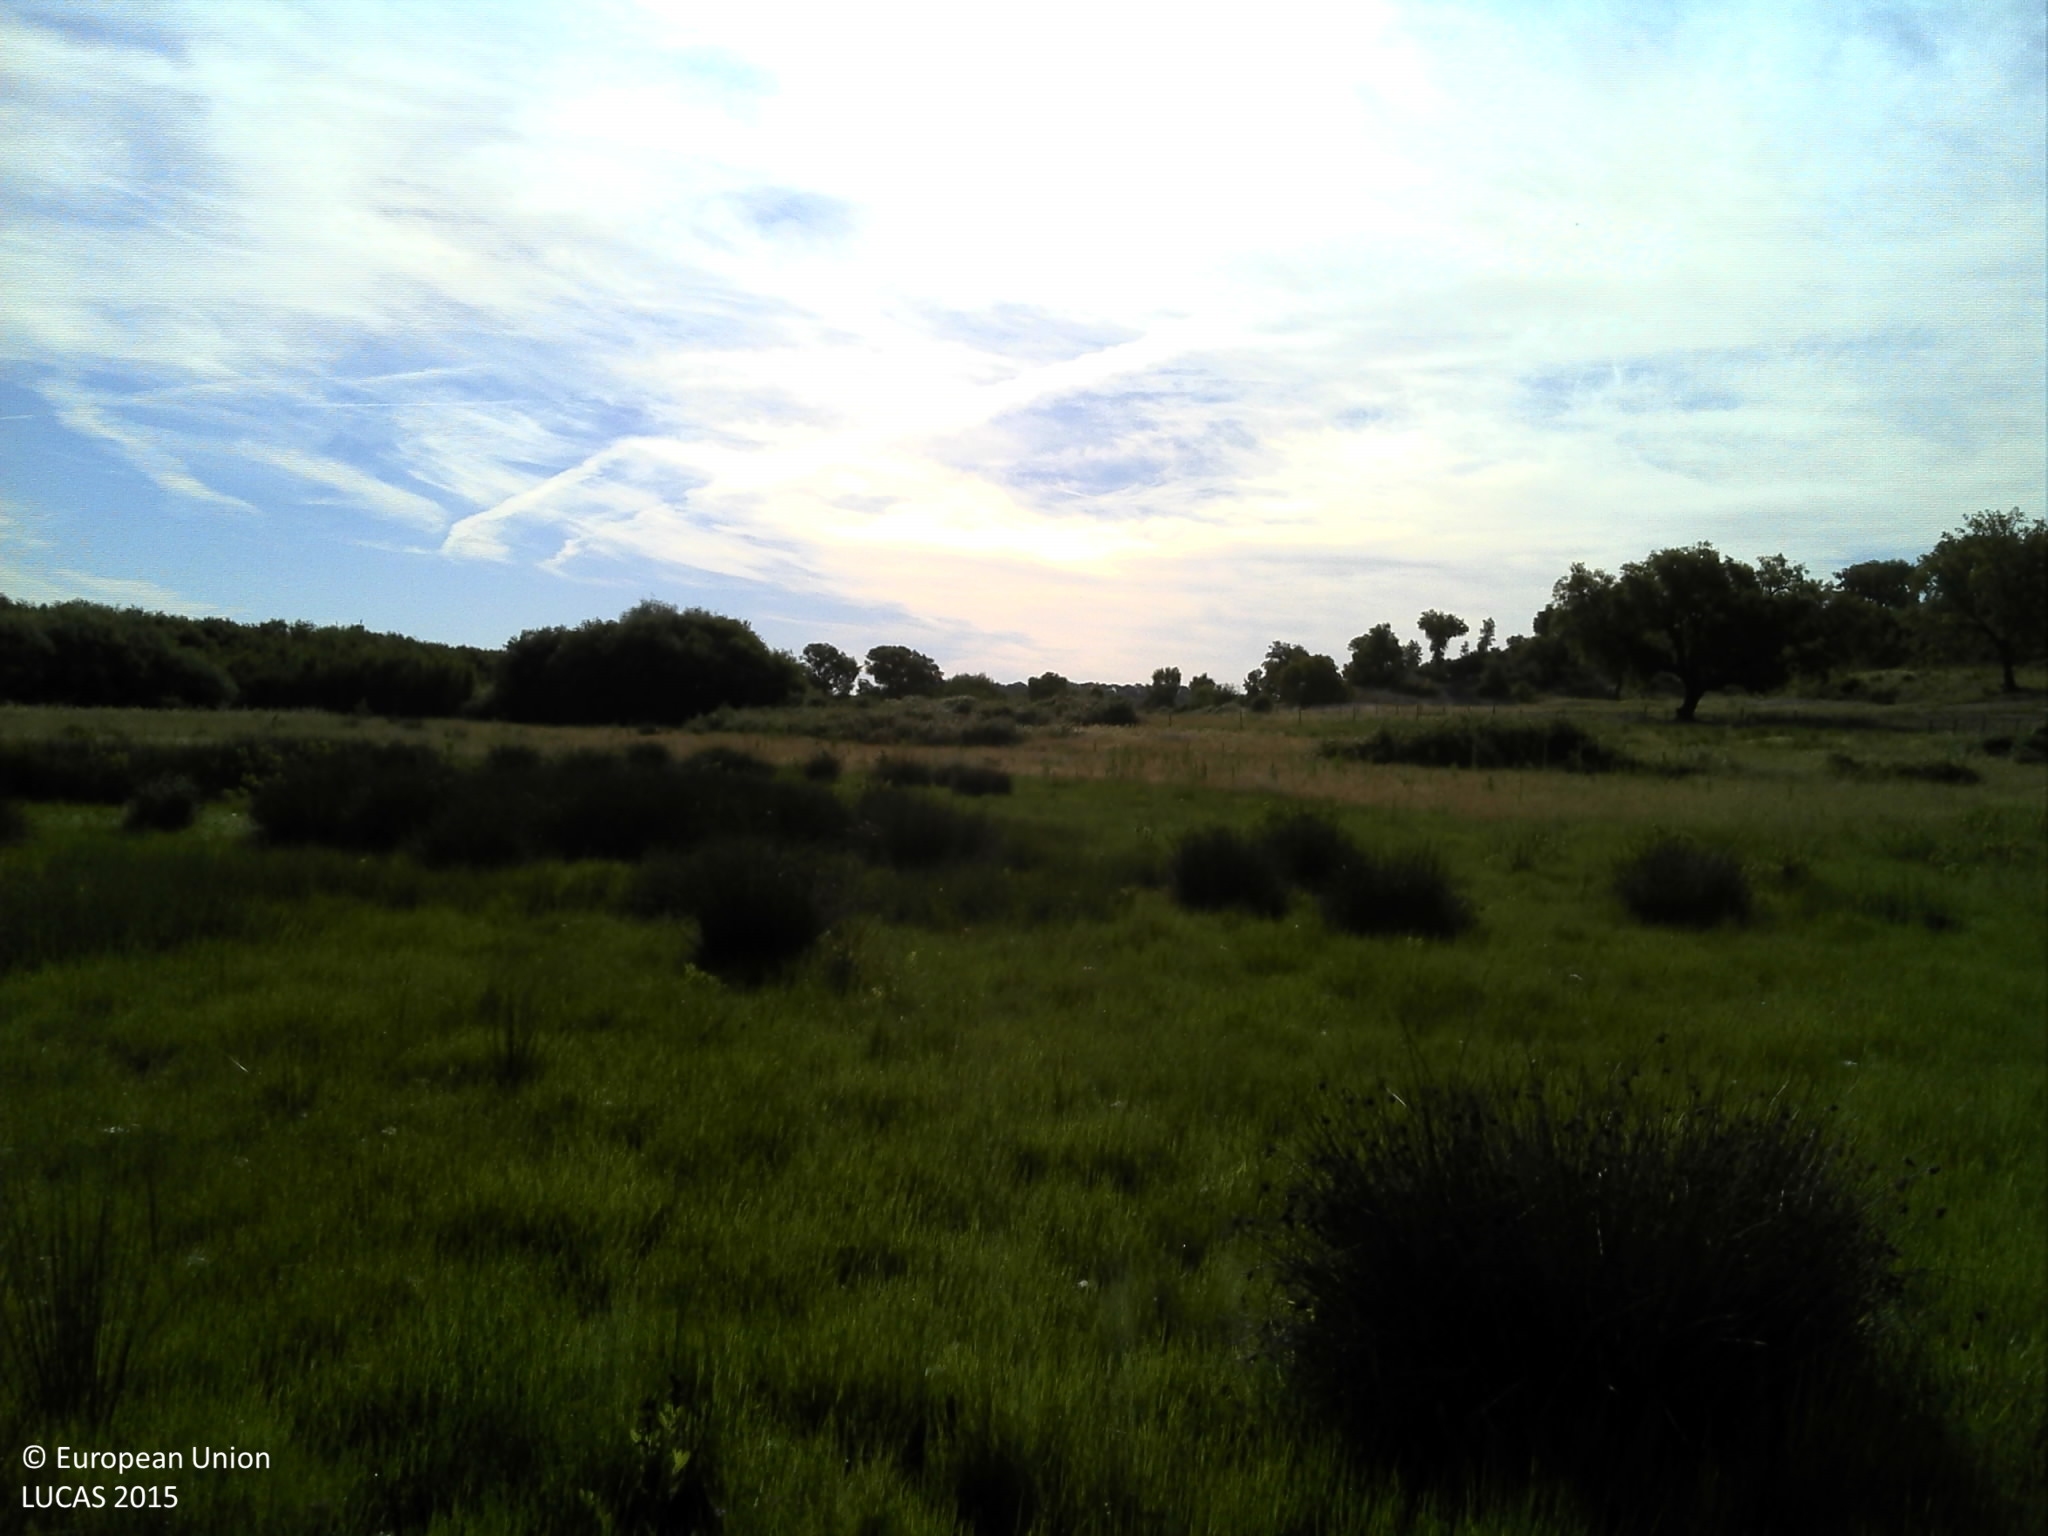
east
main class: Grassland
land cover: Grassland without tree/shrub cover
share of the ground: > 75 %
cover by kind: herbaceous plants 80 %, unconsolidated bare surface 20 %
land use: Agriculture (excluding fallow land and kitchen gardens)
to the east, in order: Grassland without tree/shrub cover; Shrubland without tree cover; Grassland without tree/shrub cover; Fences; Grassland without tree/shrub cover; Shrubland without tree cover; Grassland without tree/shrub cover
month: May
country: PT
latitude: 39.3079
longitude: -7.9011
